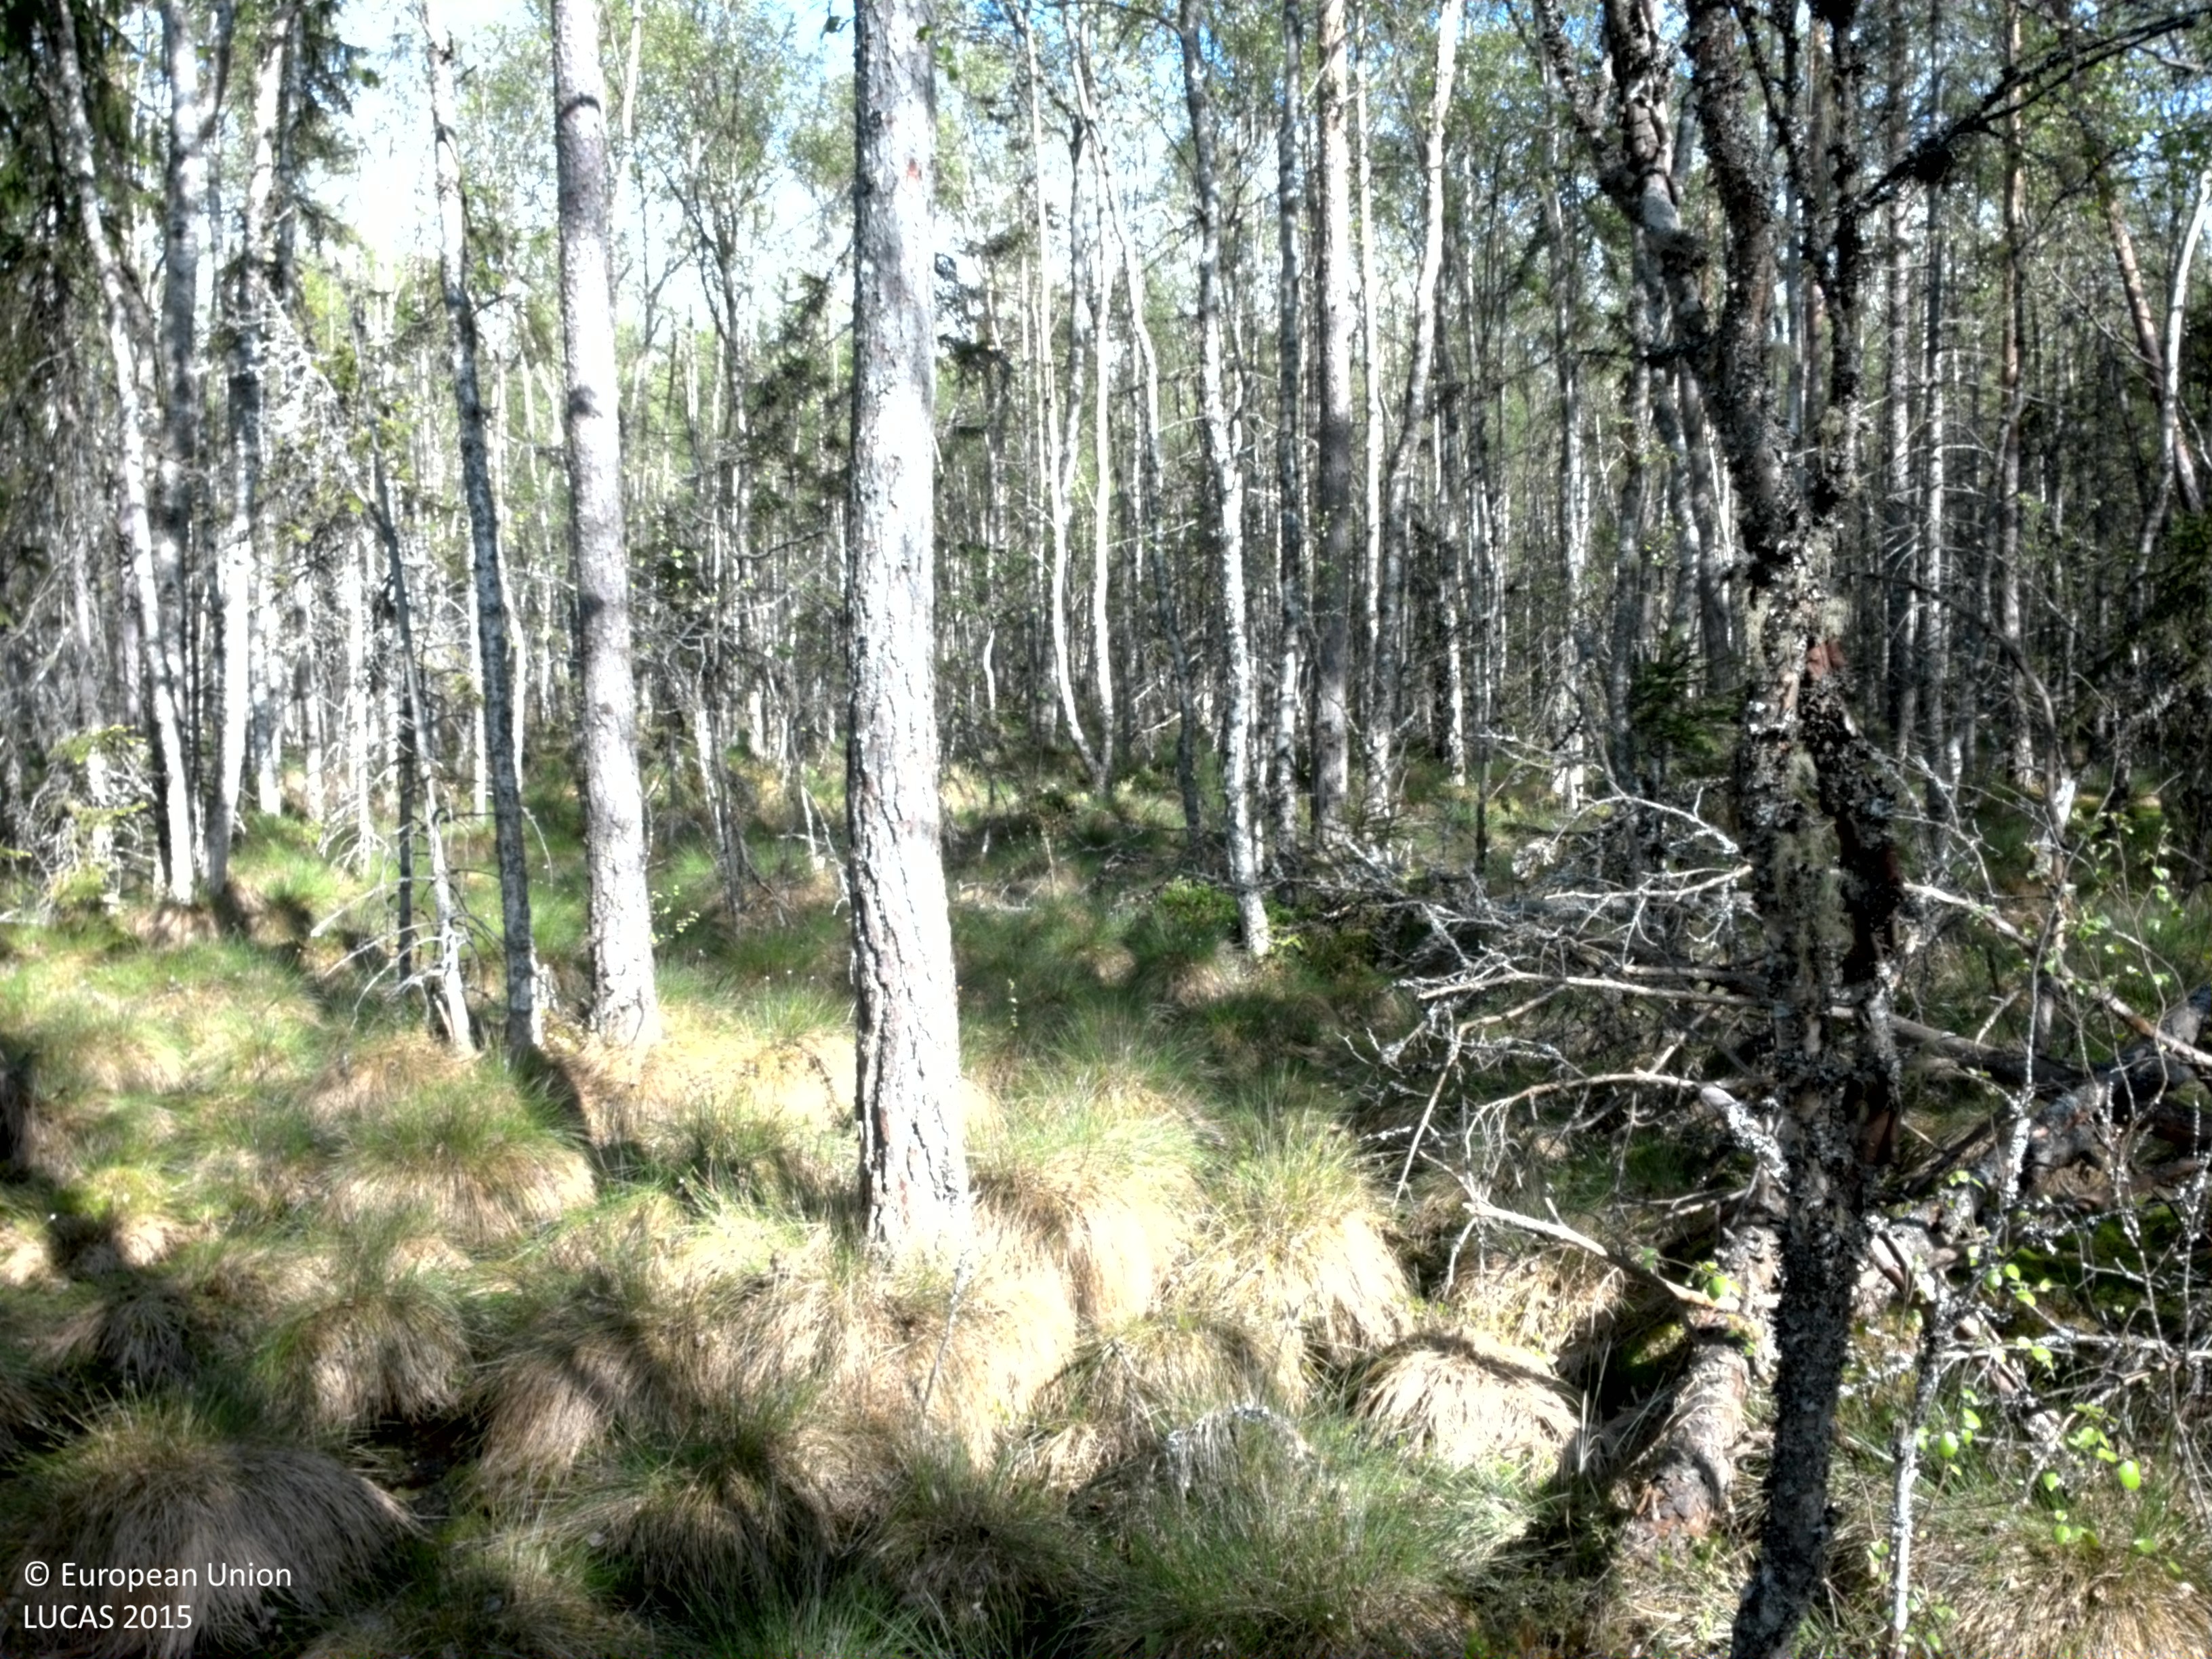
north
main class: Woodland
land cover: Broadleaved woodland
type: boreal forest
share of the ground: > 75 %
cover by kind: broadleaved forest trees 60 %, coniferous forest trees 20 %, lichens and mosses 20 %
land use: Forestry
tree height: > 5 m
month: May
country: SE
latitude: 56.7486
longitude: 15.2144
